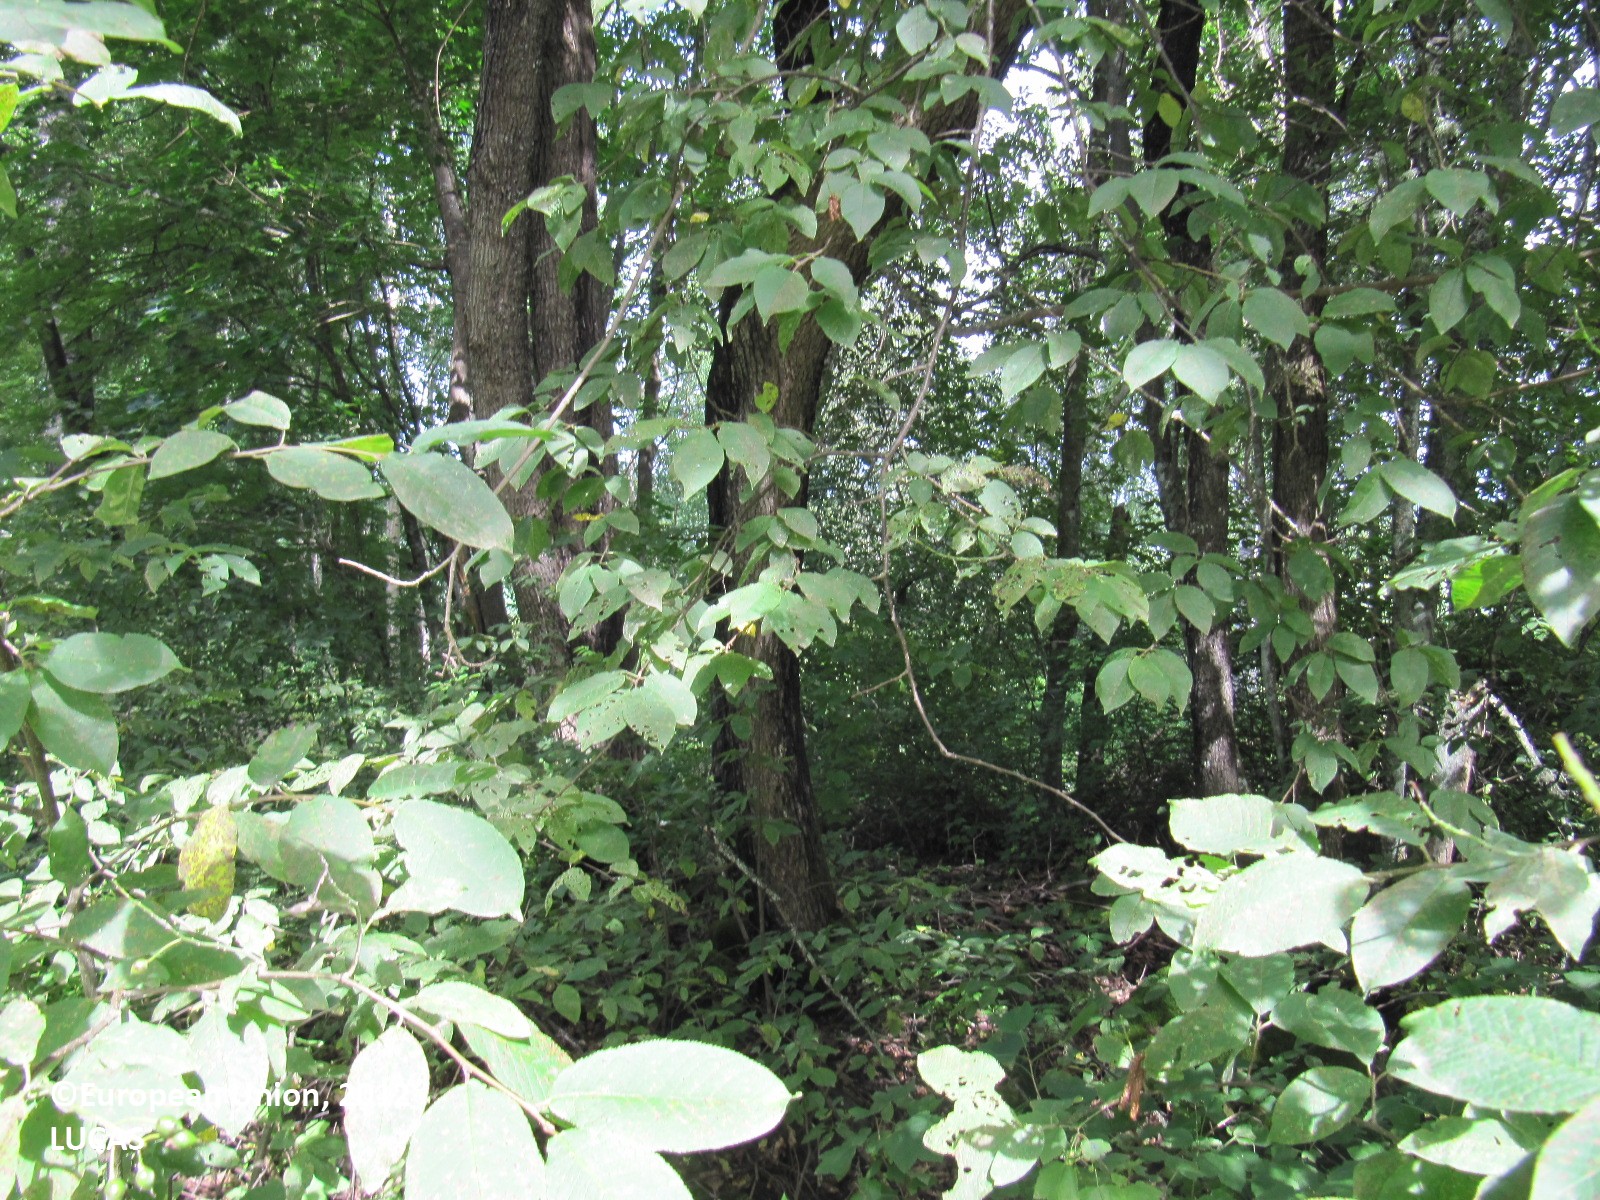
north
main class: Woodland
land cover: Broadleaved woodland
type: boreal forest
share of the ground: > 75 %
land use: Forestry
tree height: > 5 m
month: July
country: FI
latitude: 61.1718
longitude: 24.6616
